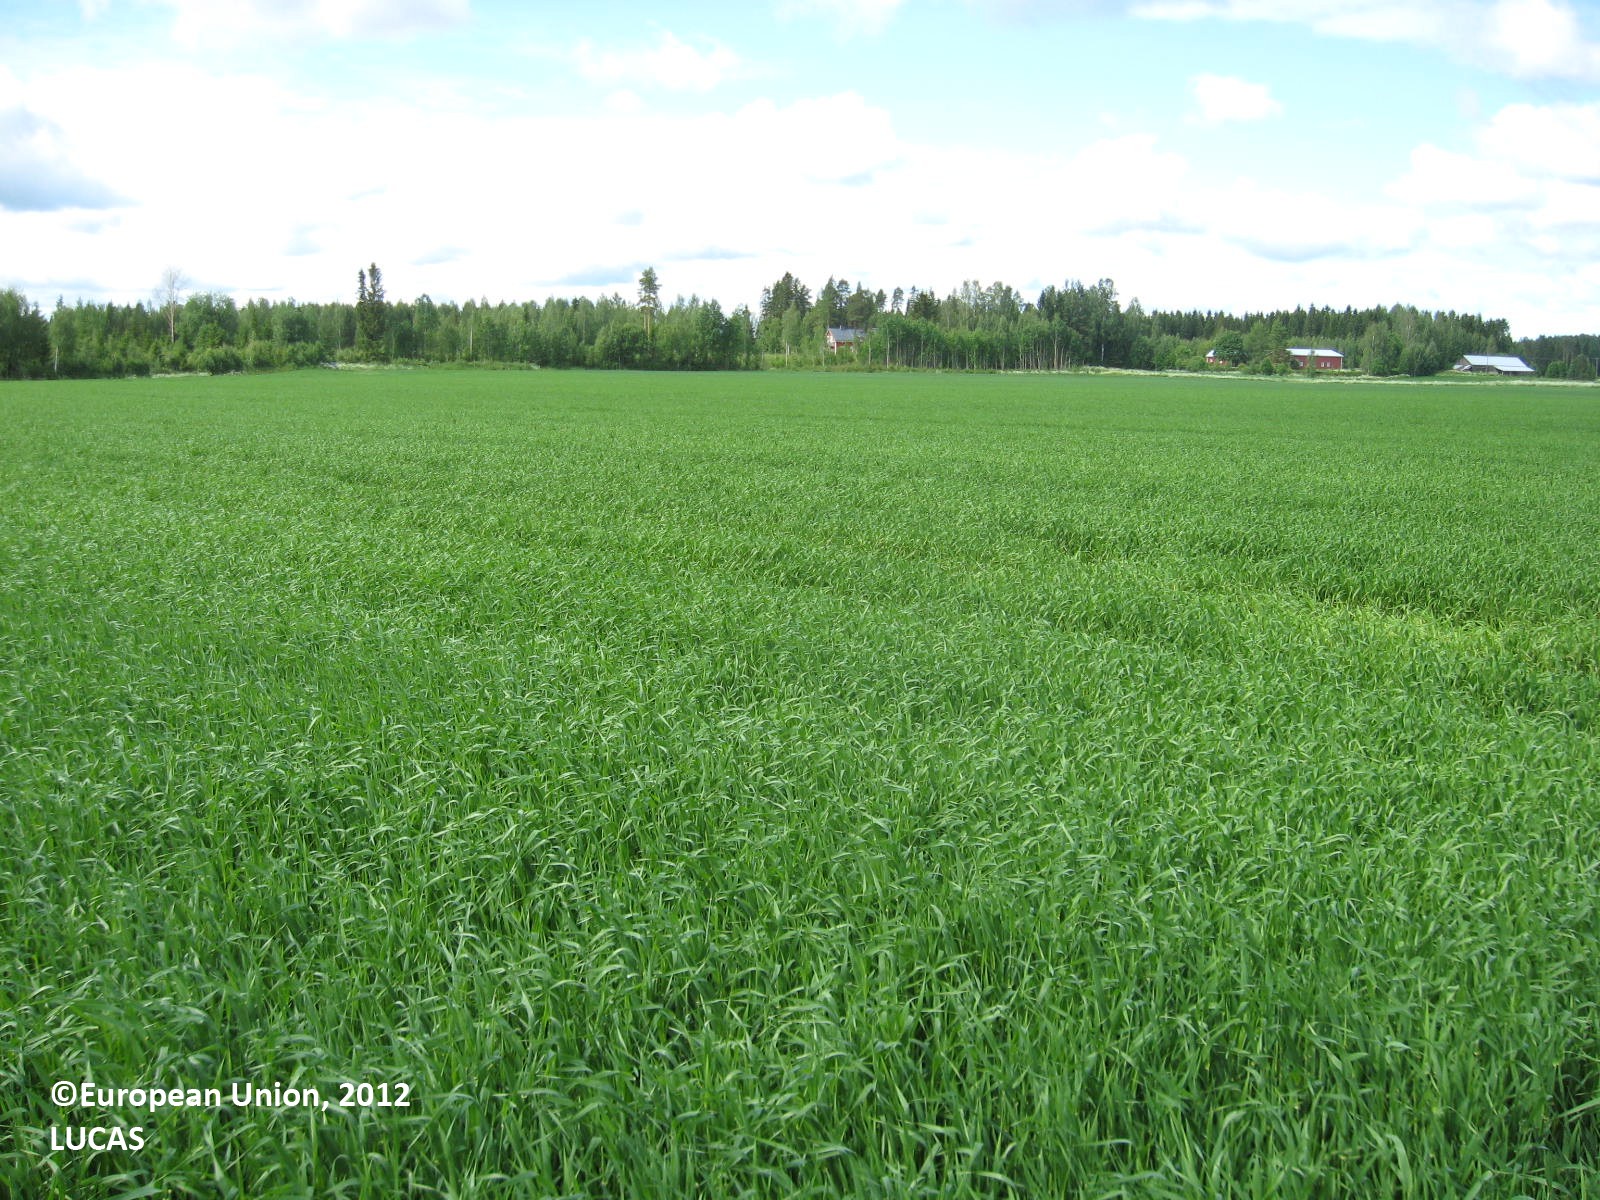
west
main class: Cropland
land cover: Barley
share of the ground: > 75 %
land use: Agriculture (excluding fallow land and kitchen gardens)
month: June
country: FI
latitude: 62.8168
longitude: 22.5523
